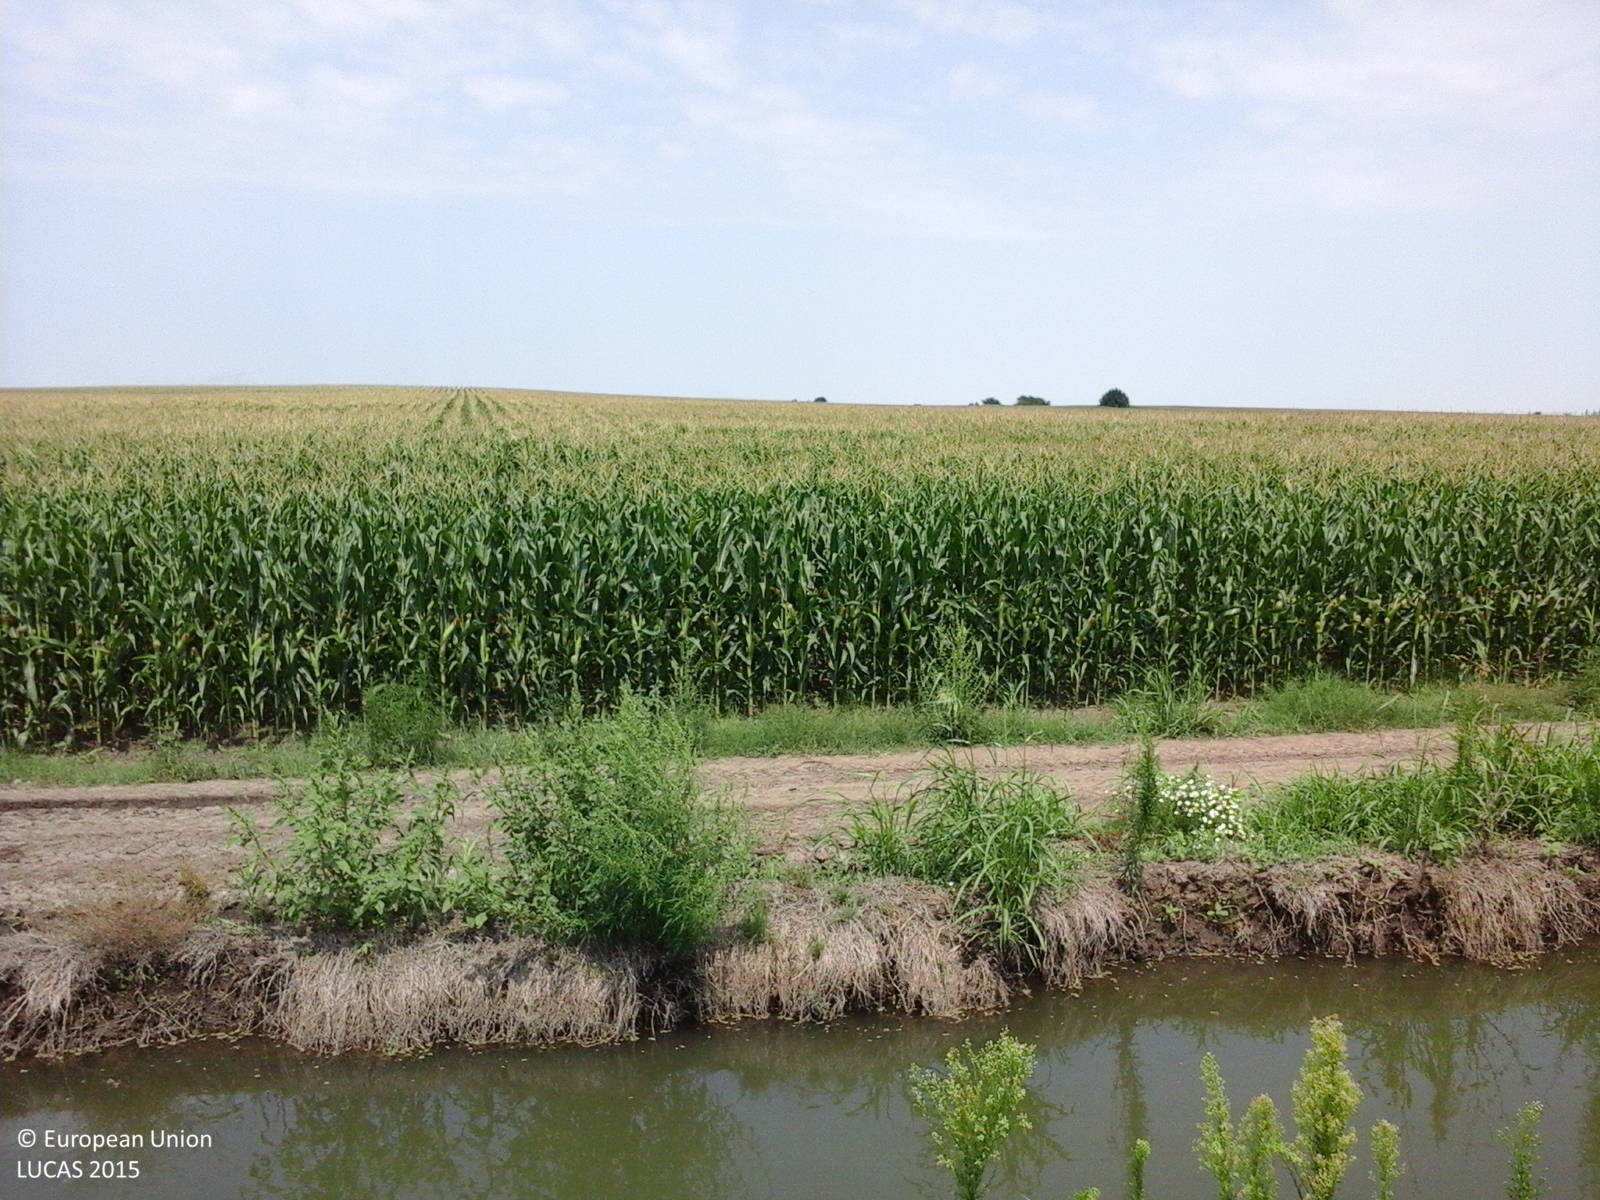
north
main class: Cropland
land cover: Maize
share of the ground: > 75 %
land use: Agriculture (excluding fallow land and kitchen gardens)
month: July
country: RO
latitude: 44.4748
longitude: 27.5818
